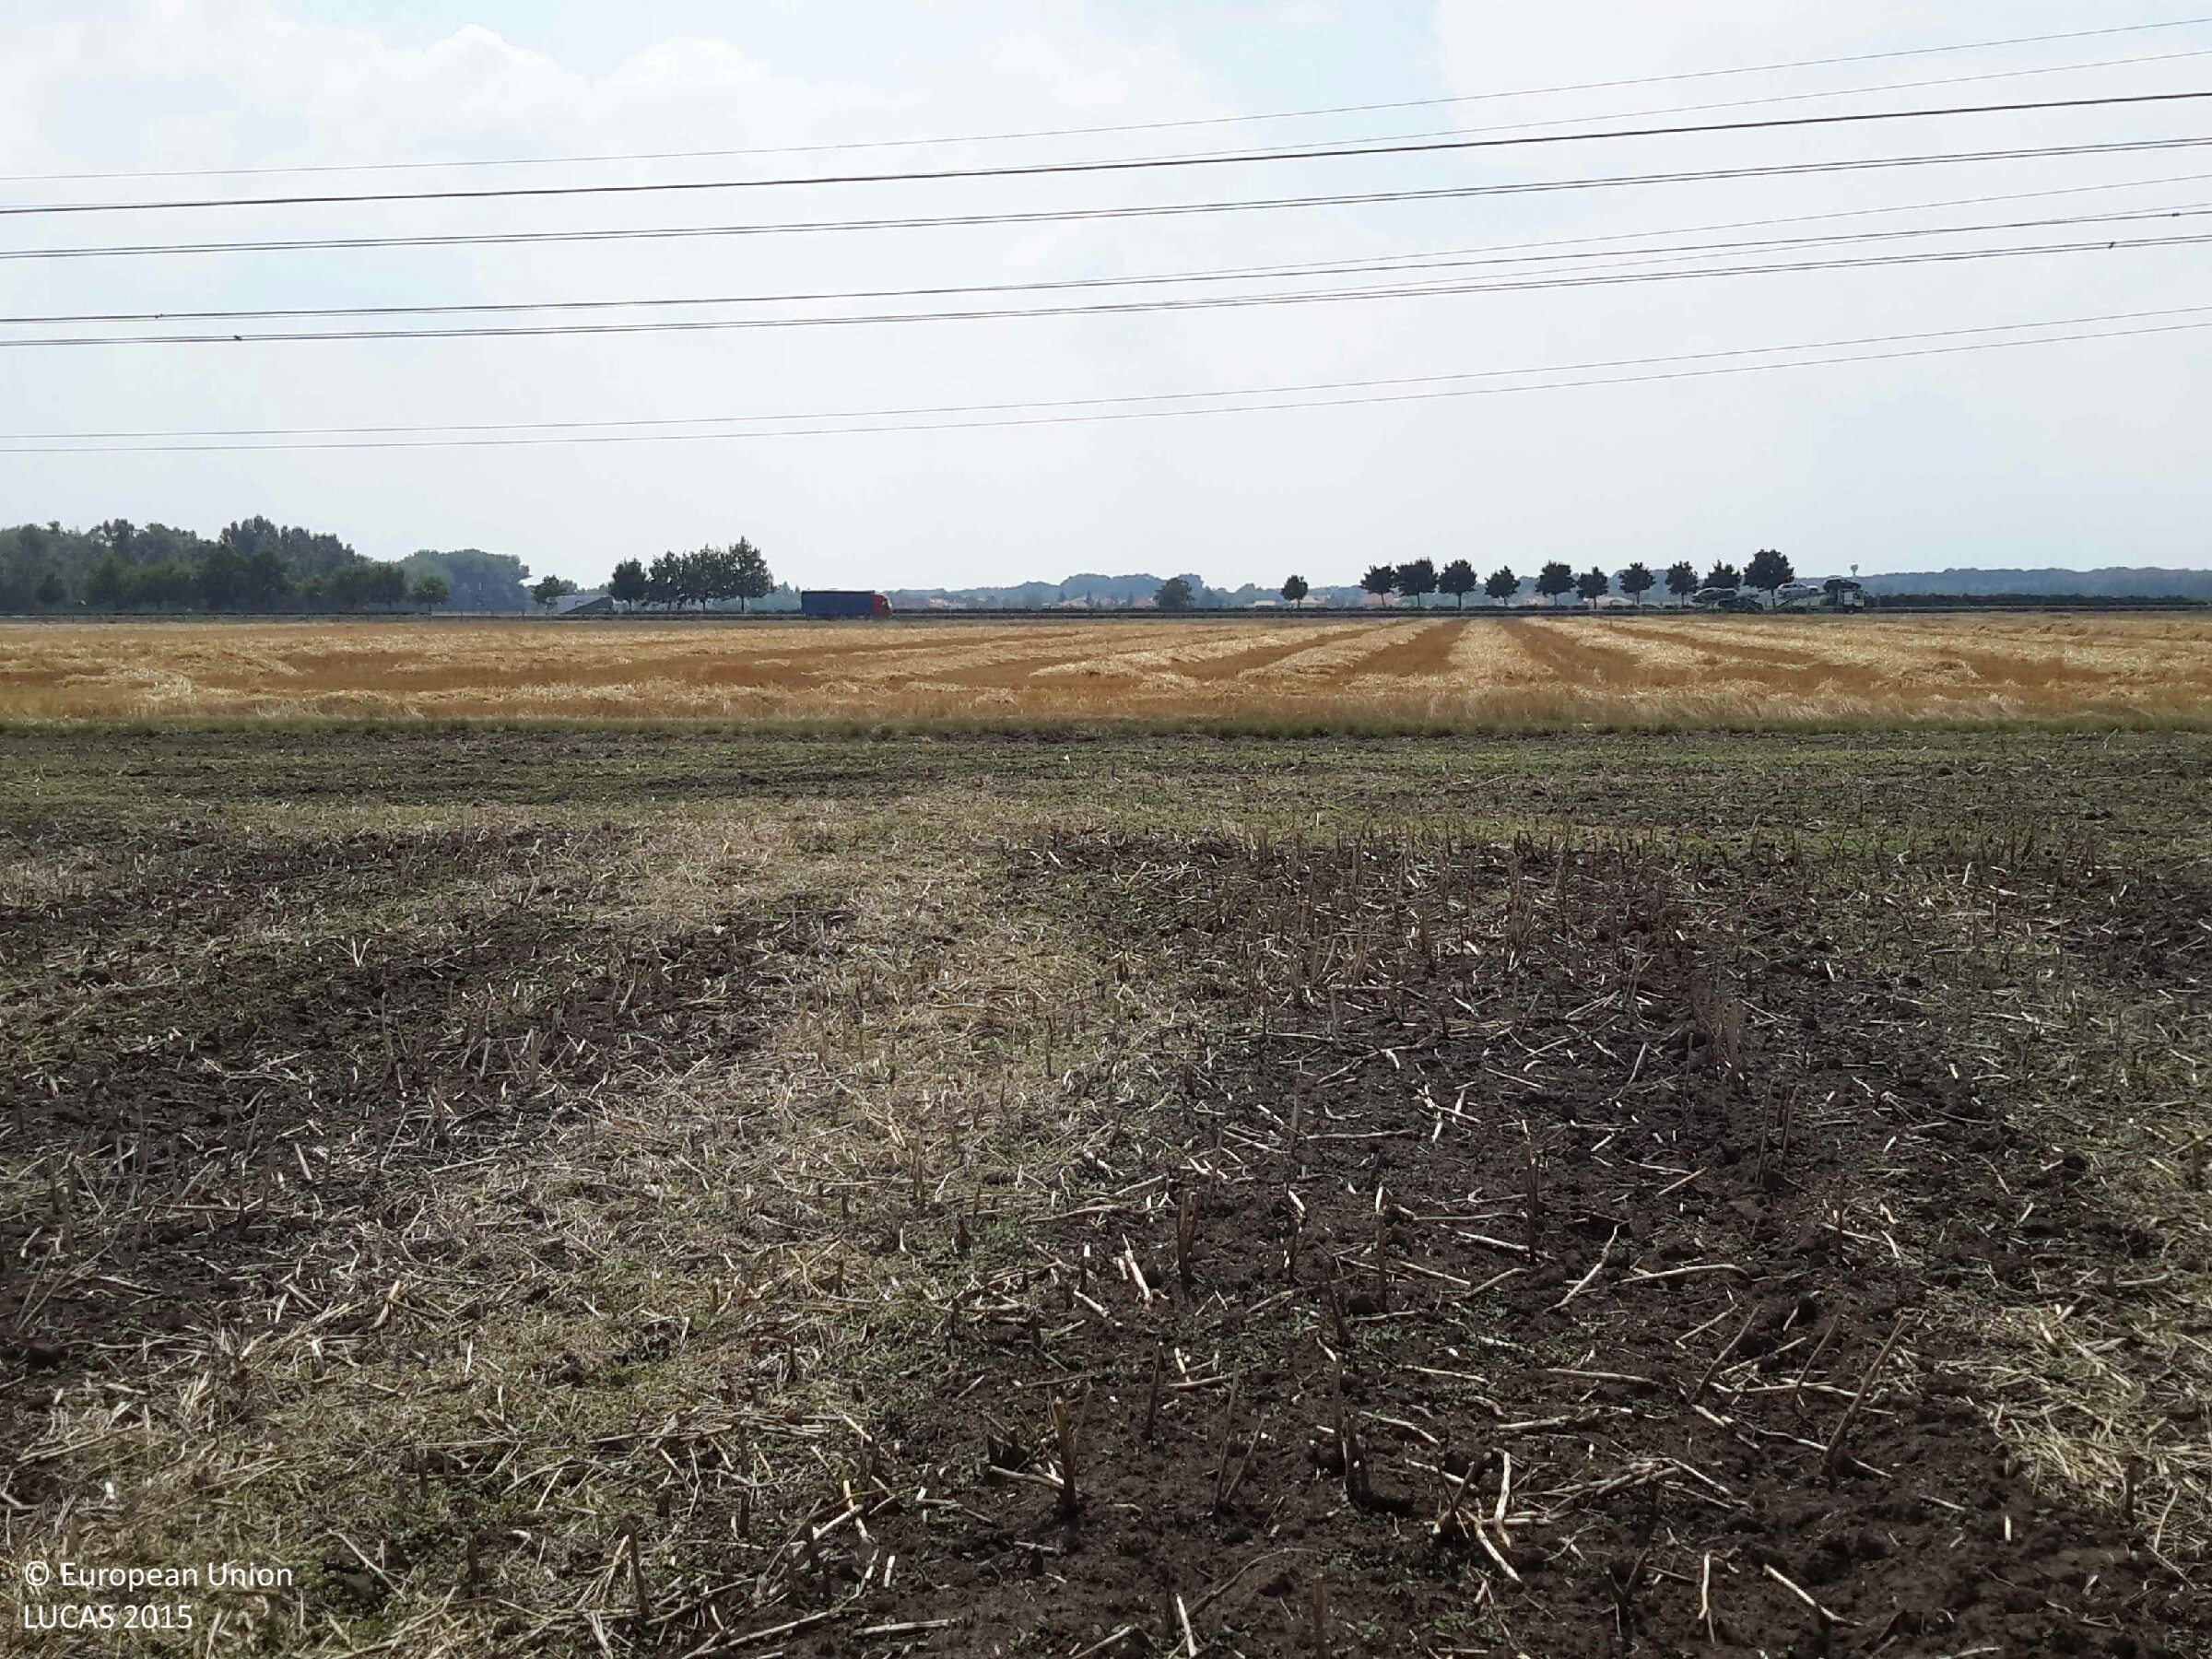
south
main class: Cropland
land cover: Rape and turnip rape
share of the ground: < 10 %
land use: Agriculture (excluding fallow land and kitchen gardens)
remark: Harvested field
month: August
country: HU
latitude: 47.7570
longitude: 17.4122
